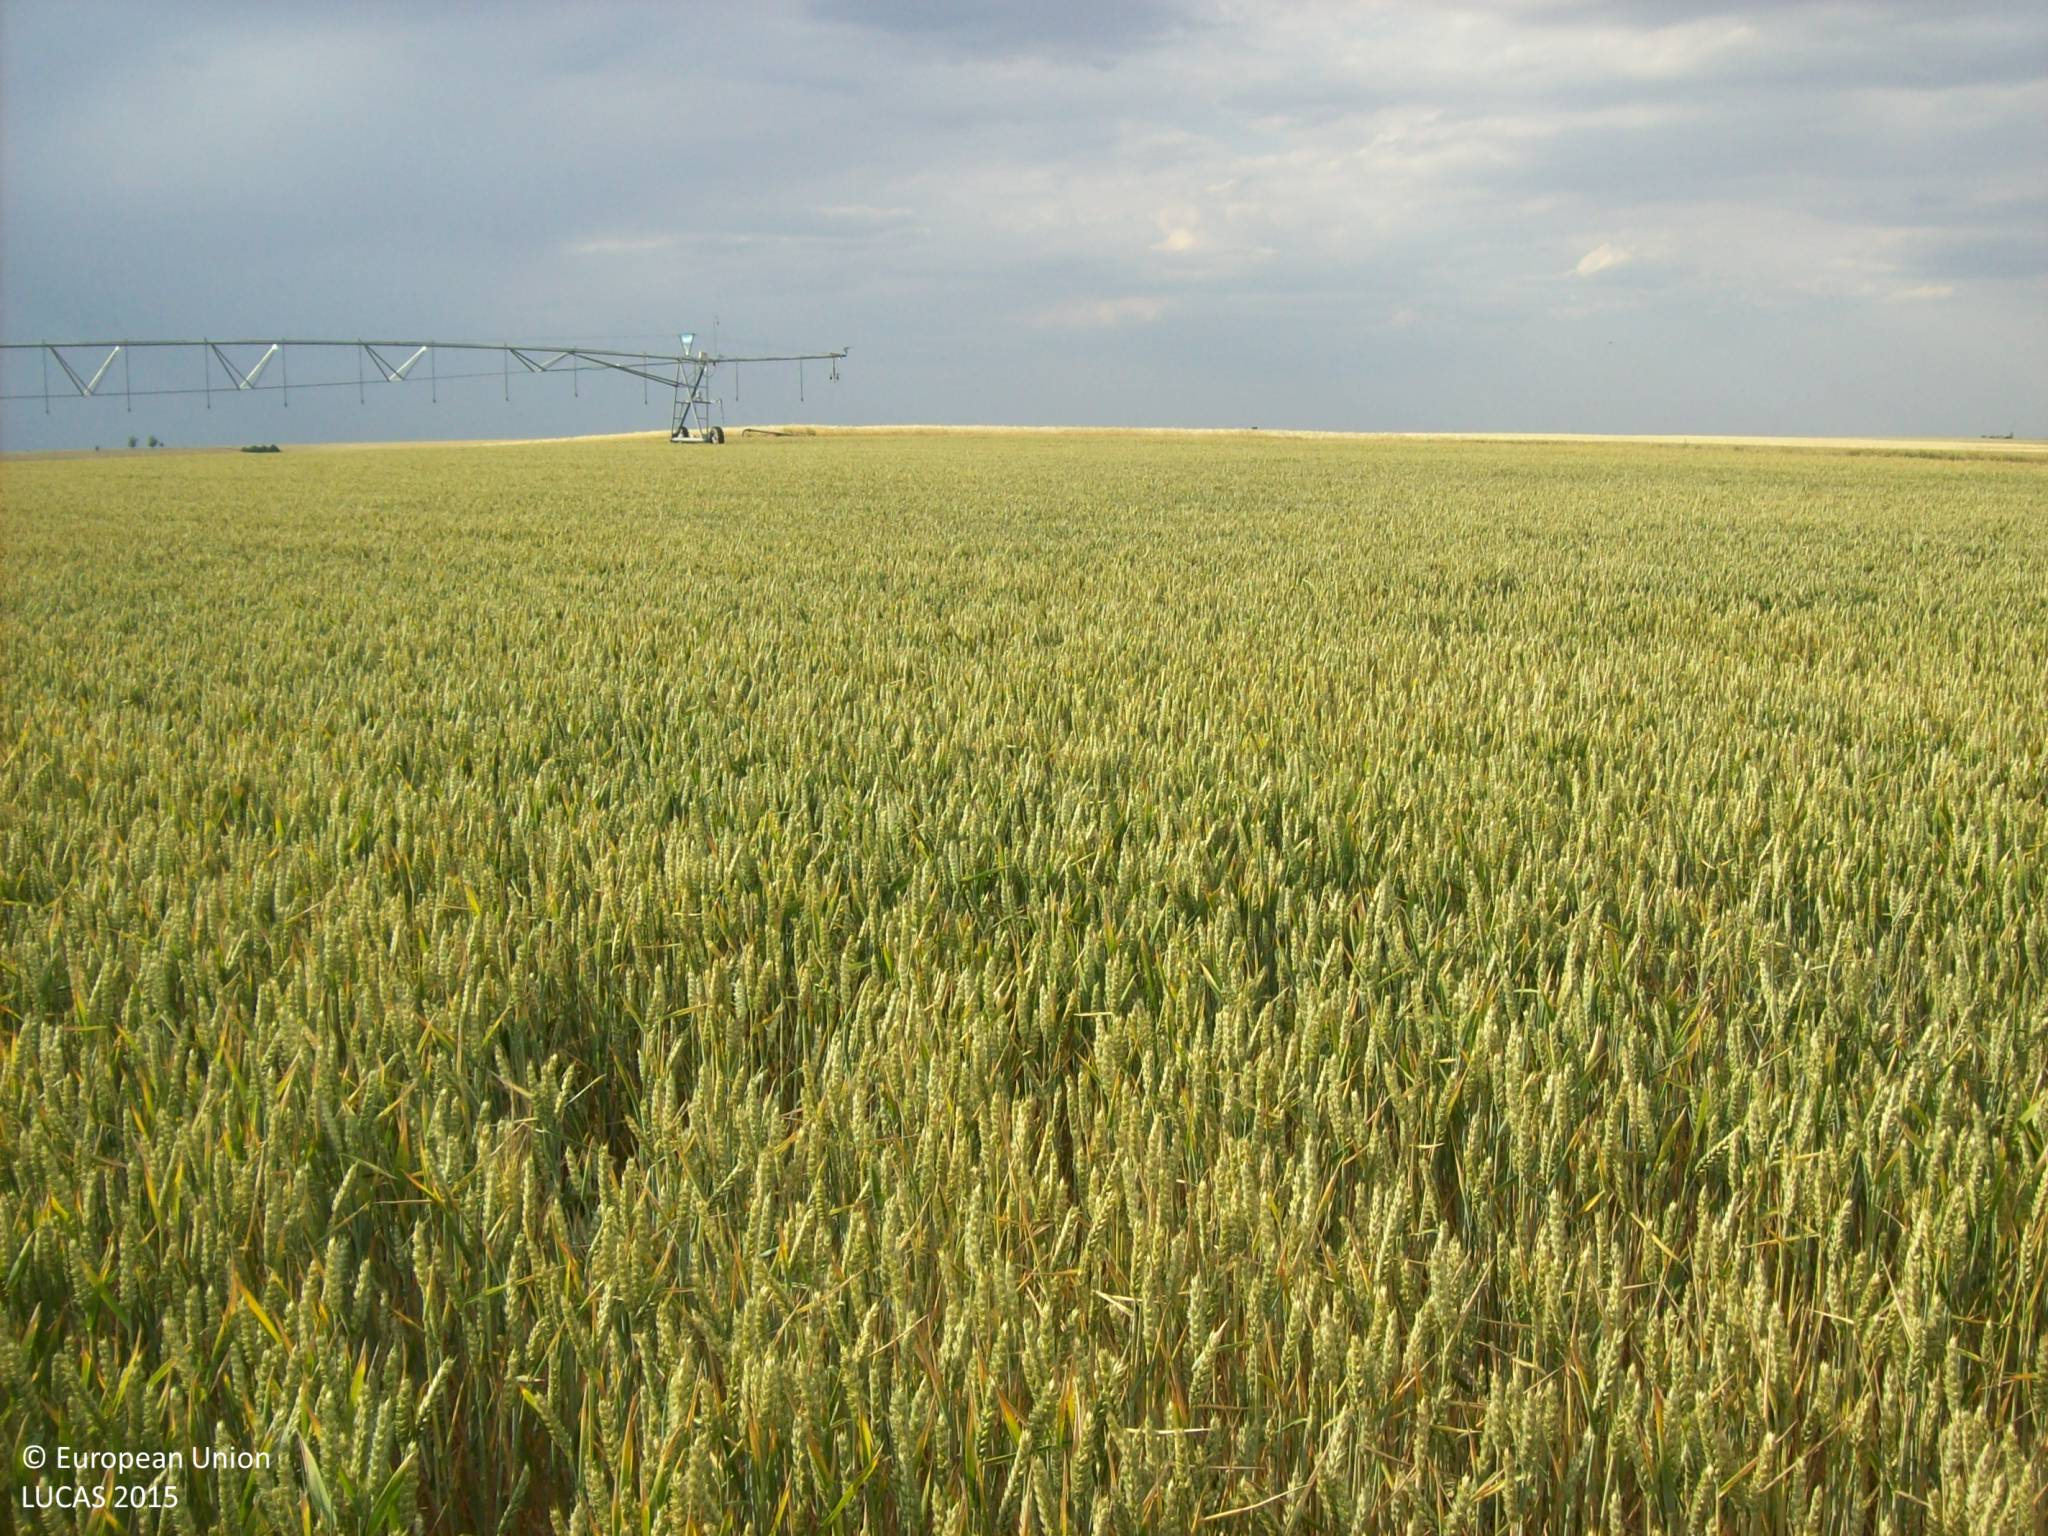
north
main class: Cropland
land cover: Common wheat
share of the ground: > 75 %
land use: Agriculture (excluding fallow land and kitchen gardens)
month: June
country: ES
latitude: 41.0459
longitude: -5.0448
